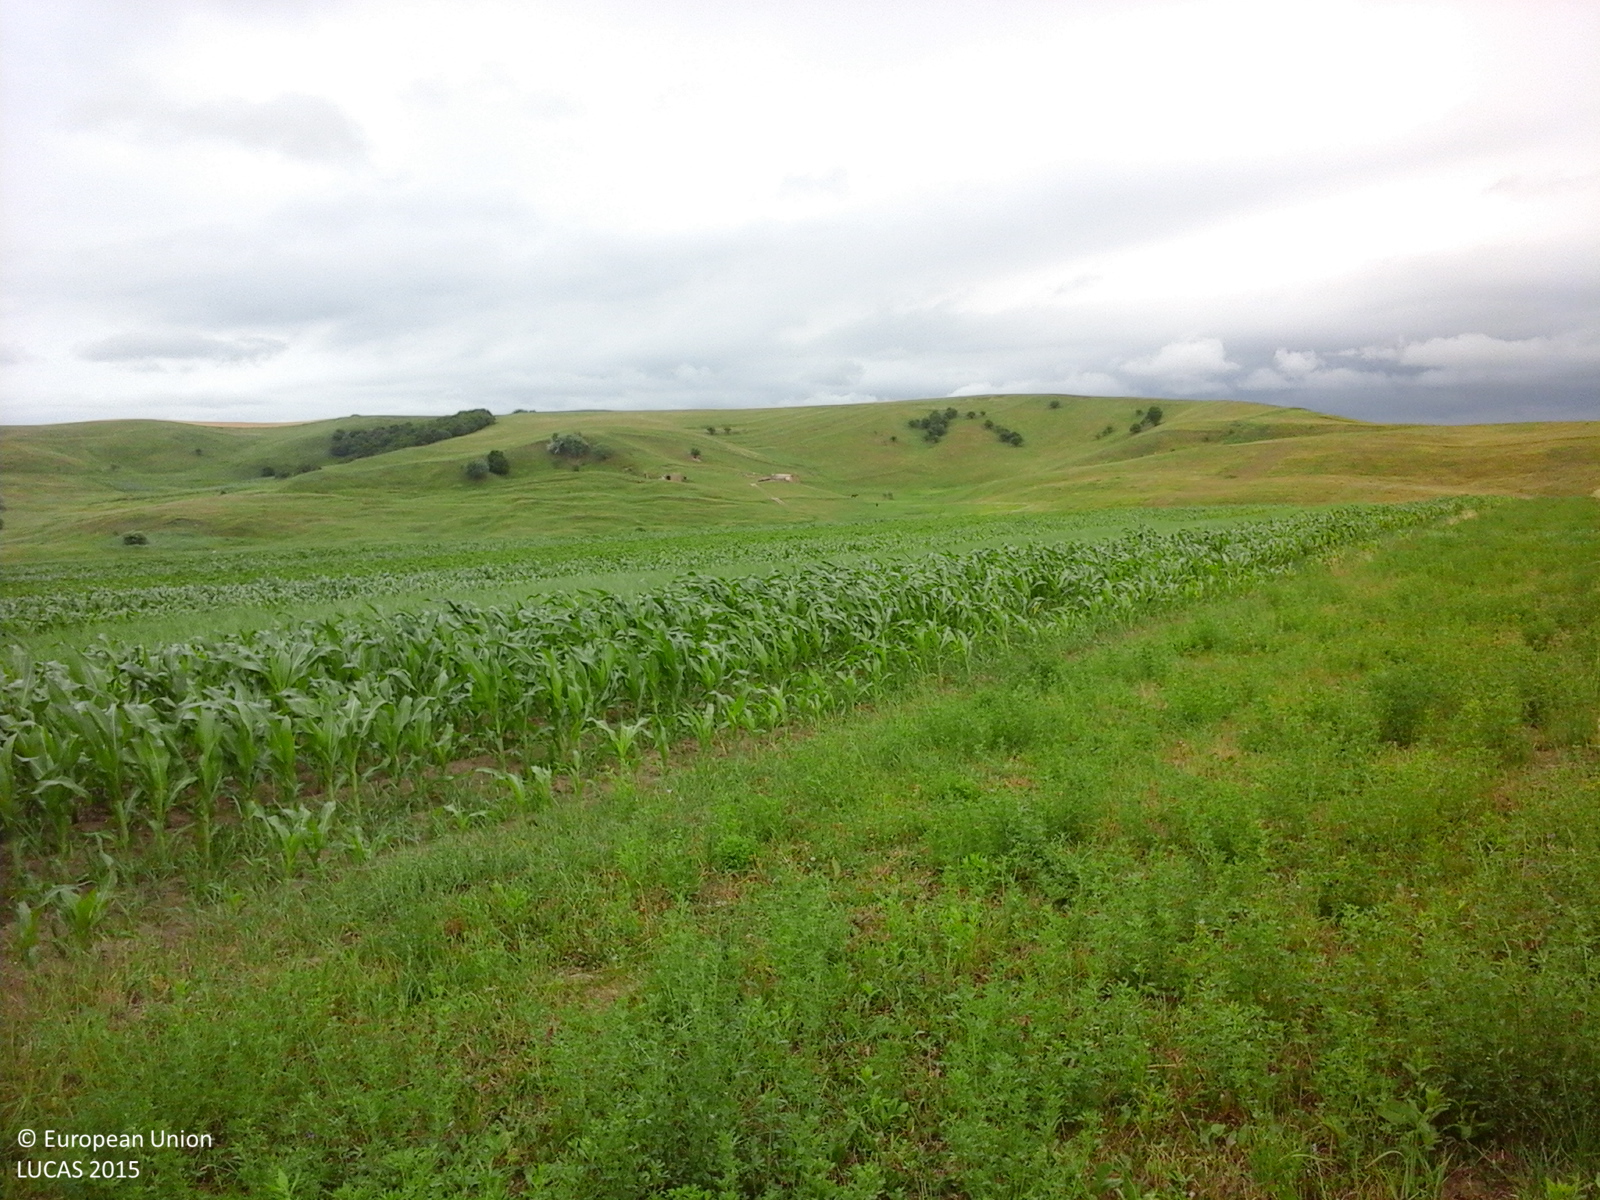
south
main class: Cropland
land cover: Lucerne
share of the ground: > 75 %
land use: Agriculture (excluding fallow land and kitchen gardens)
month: June
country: RO
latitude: 48.0856
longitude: 26.4009
